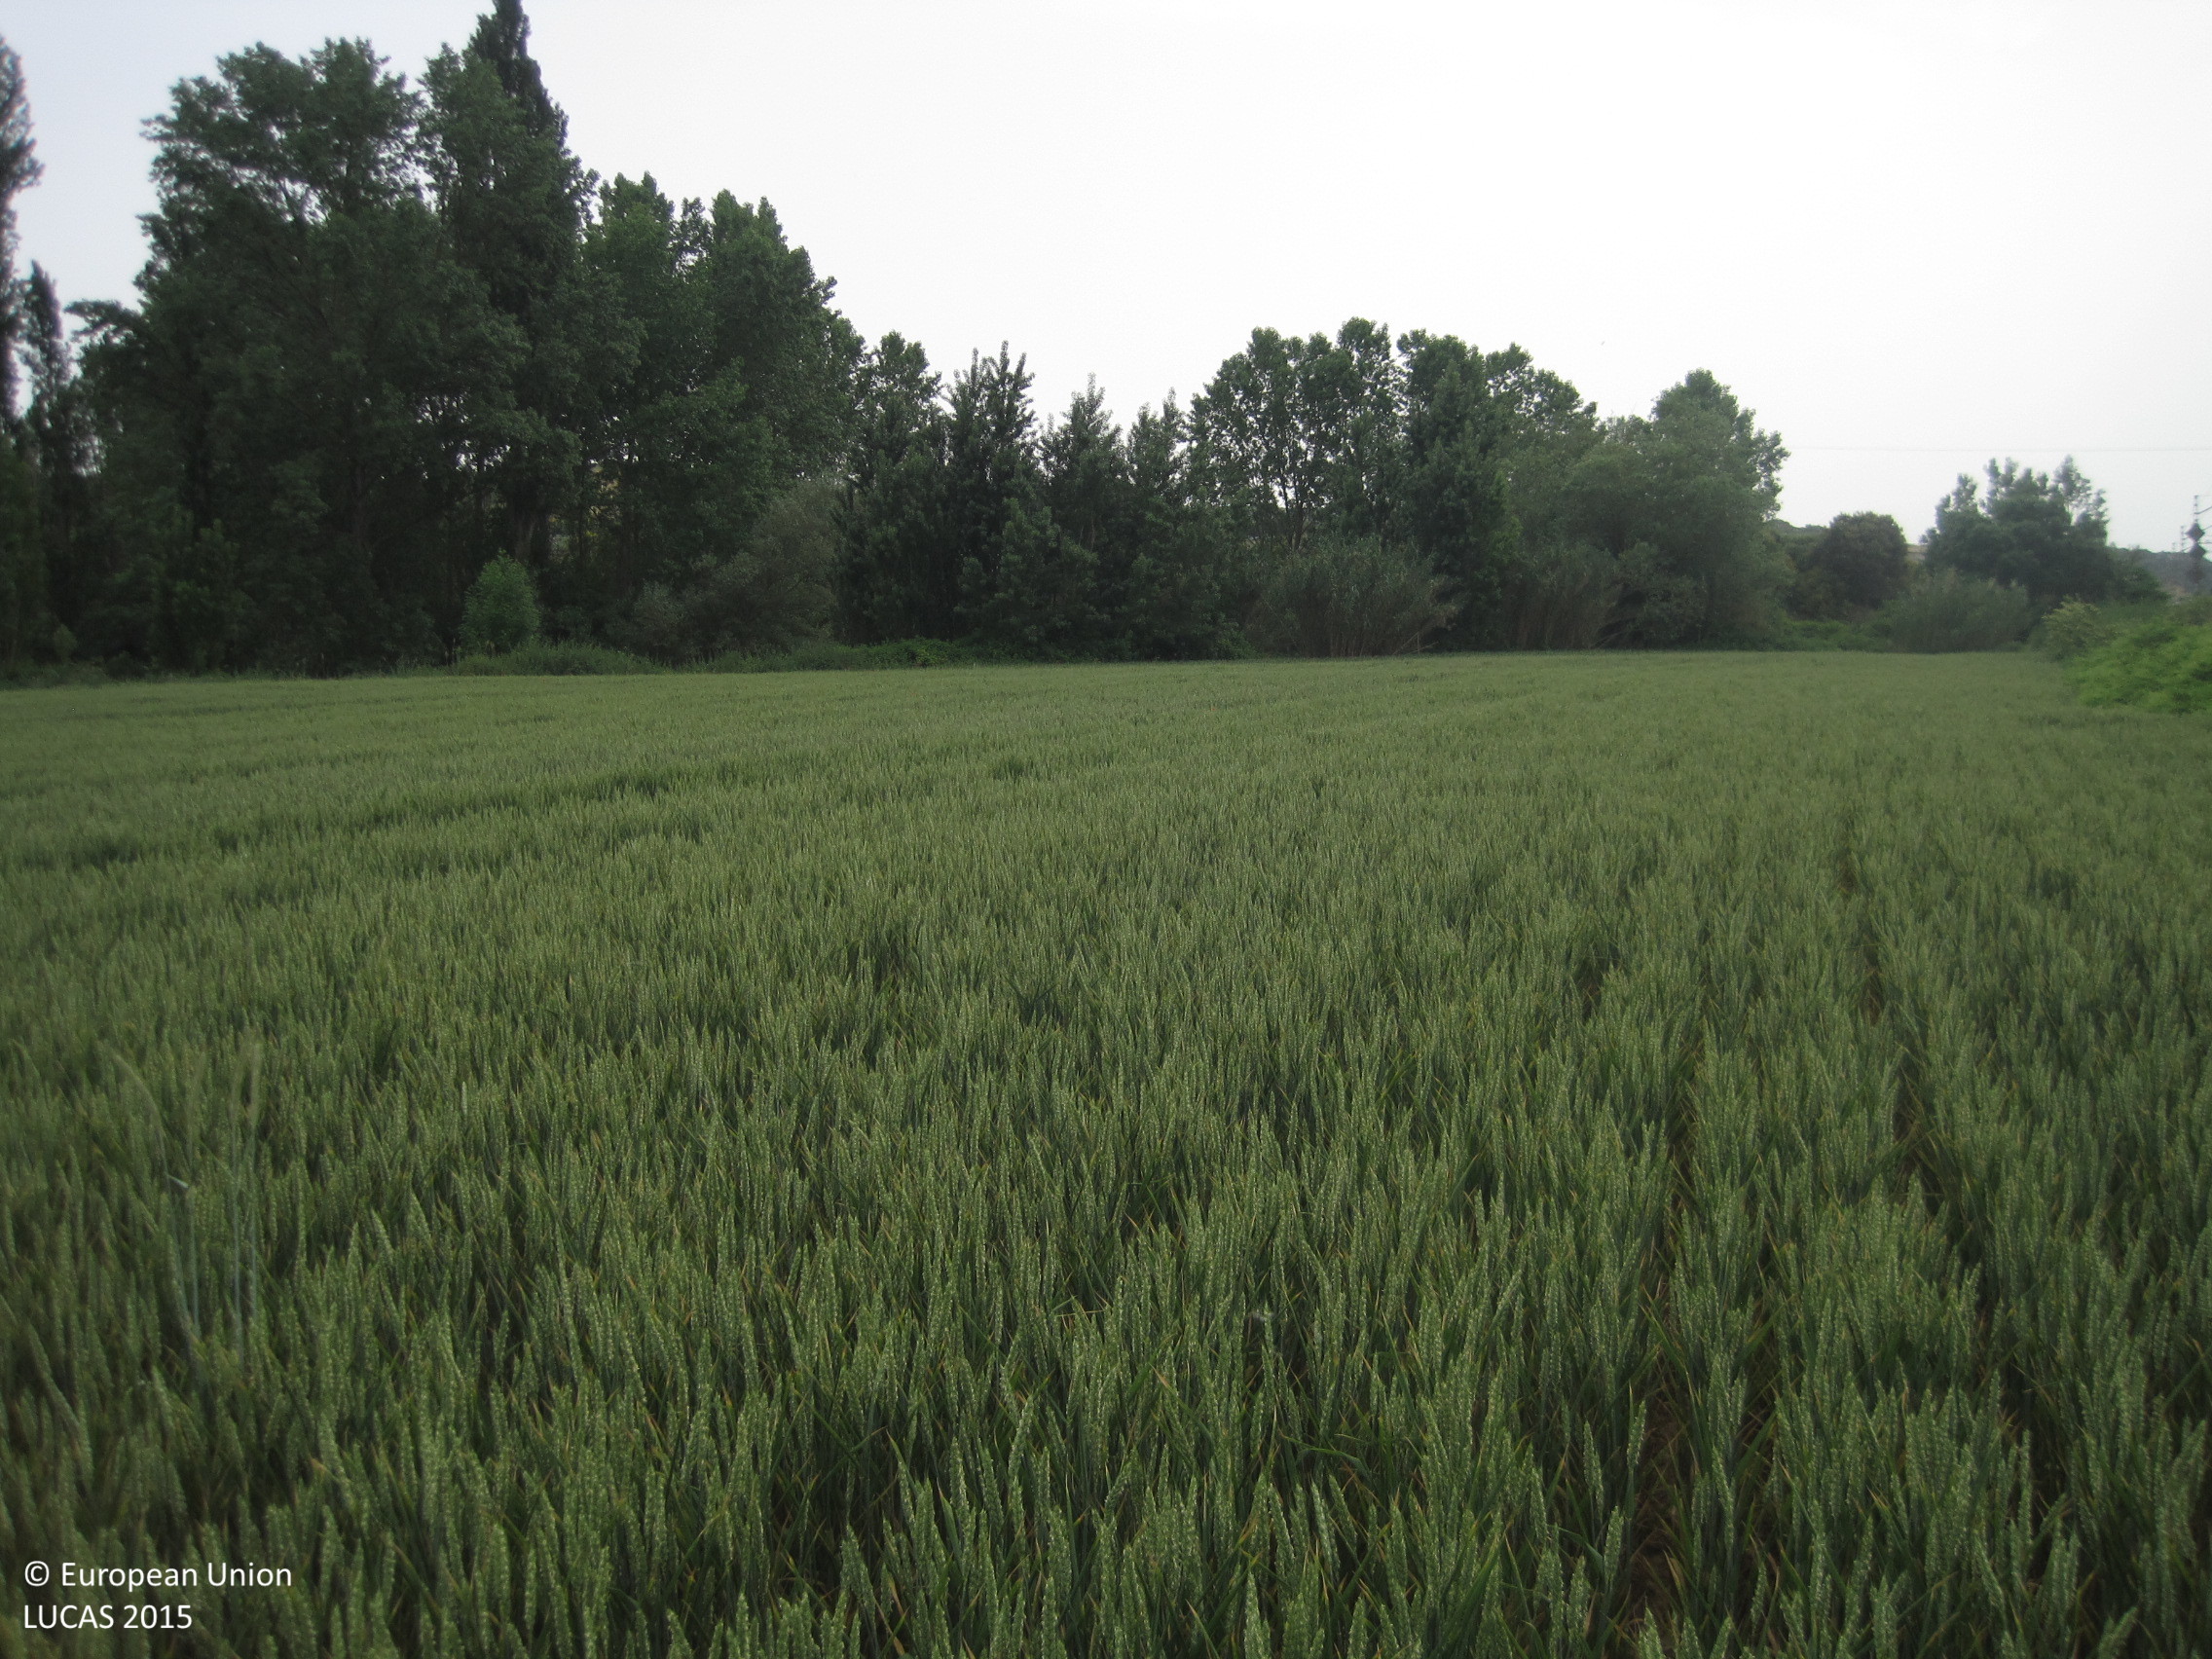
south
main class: Cropland
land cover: Common wheat
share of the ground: > 75 %
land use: Agriculture (excluding fallow land and kitchen gardens)
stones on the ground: < 10 %
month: May
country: ES
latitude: 42.5632
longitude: -1.6451
